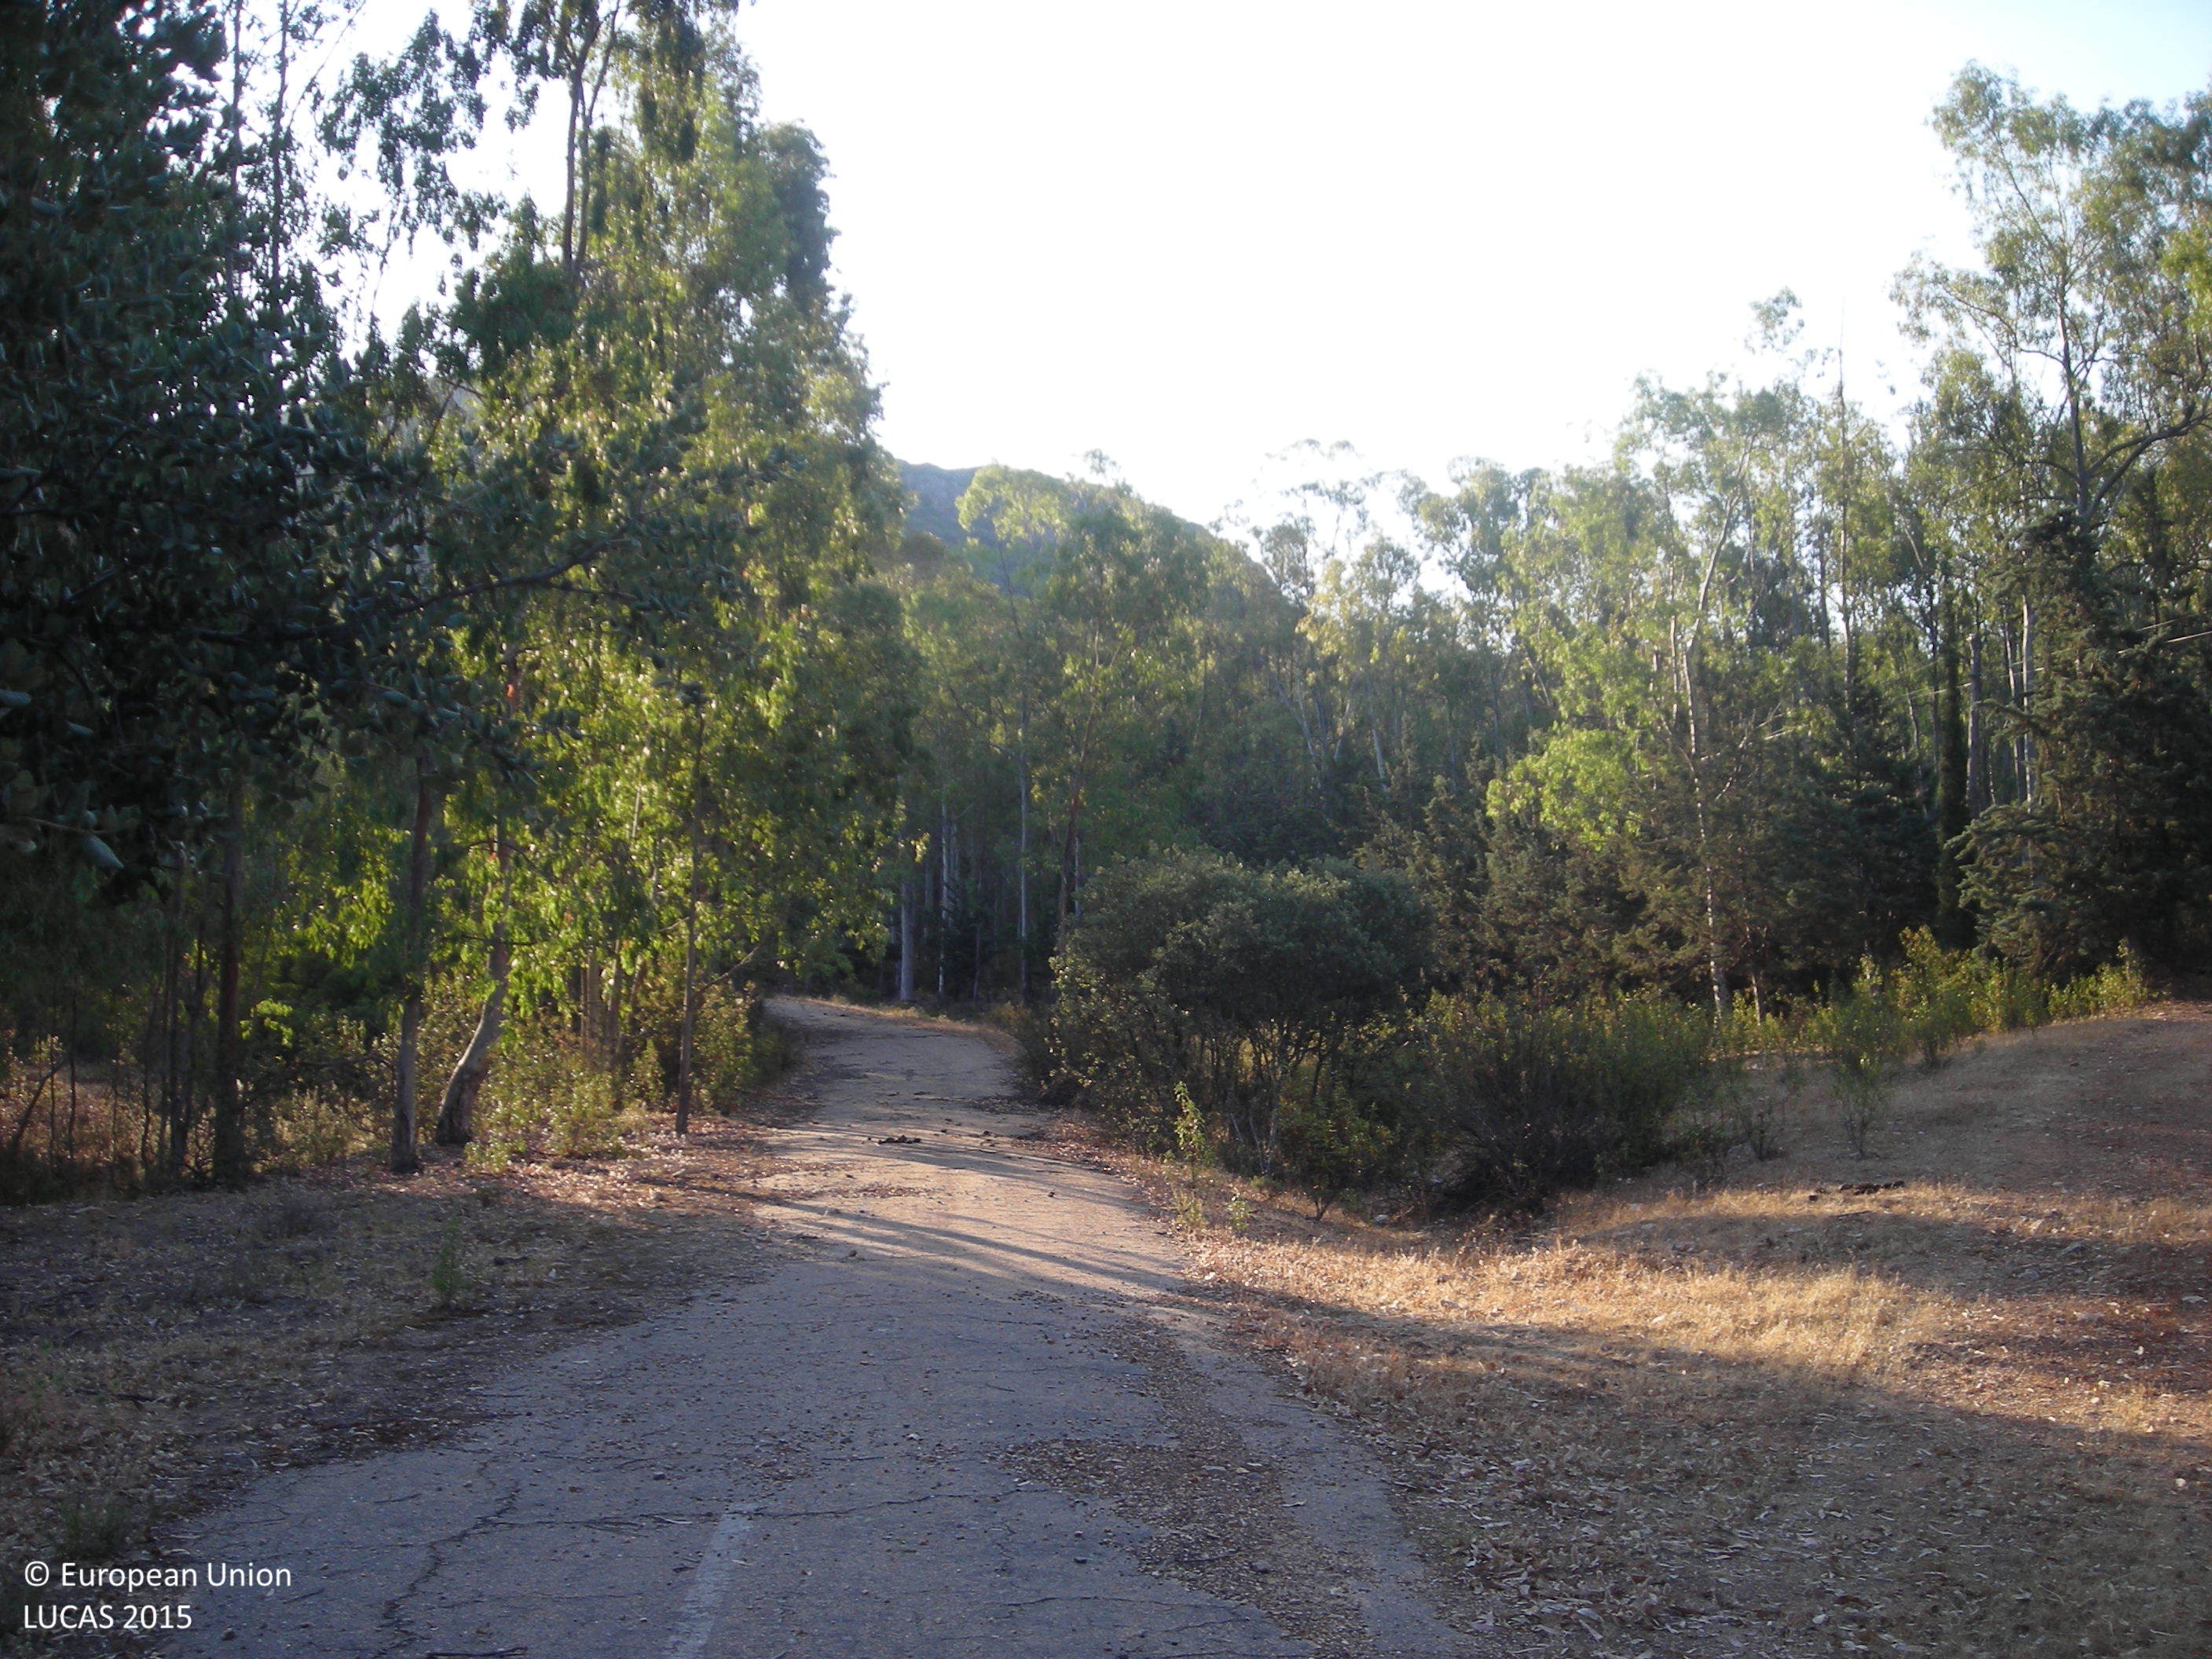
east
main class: Woodland
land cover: Broadleaved woodland
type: exotic forest
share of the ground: > 75 %
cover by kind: broadleaved forest trees 100 %
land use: Forestry
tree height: > 5 m
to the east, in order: Broadleaved woodland; Tracks; Broadleaved woodland
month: June
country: ES
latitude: 39.0504
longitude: -5.4699
